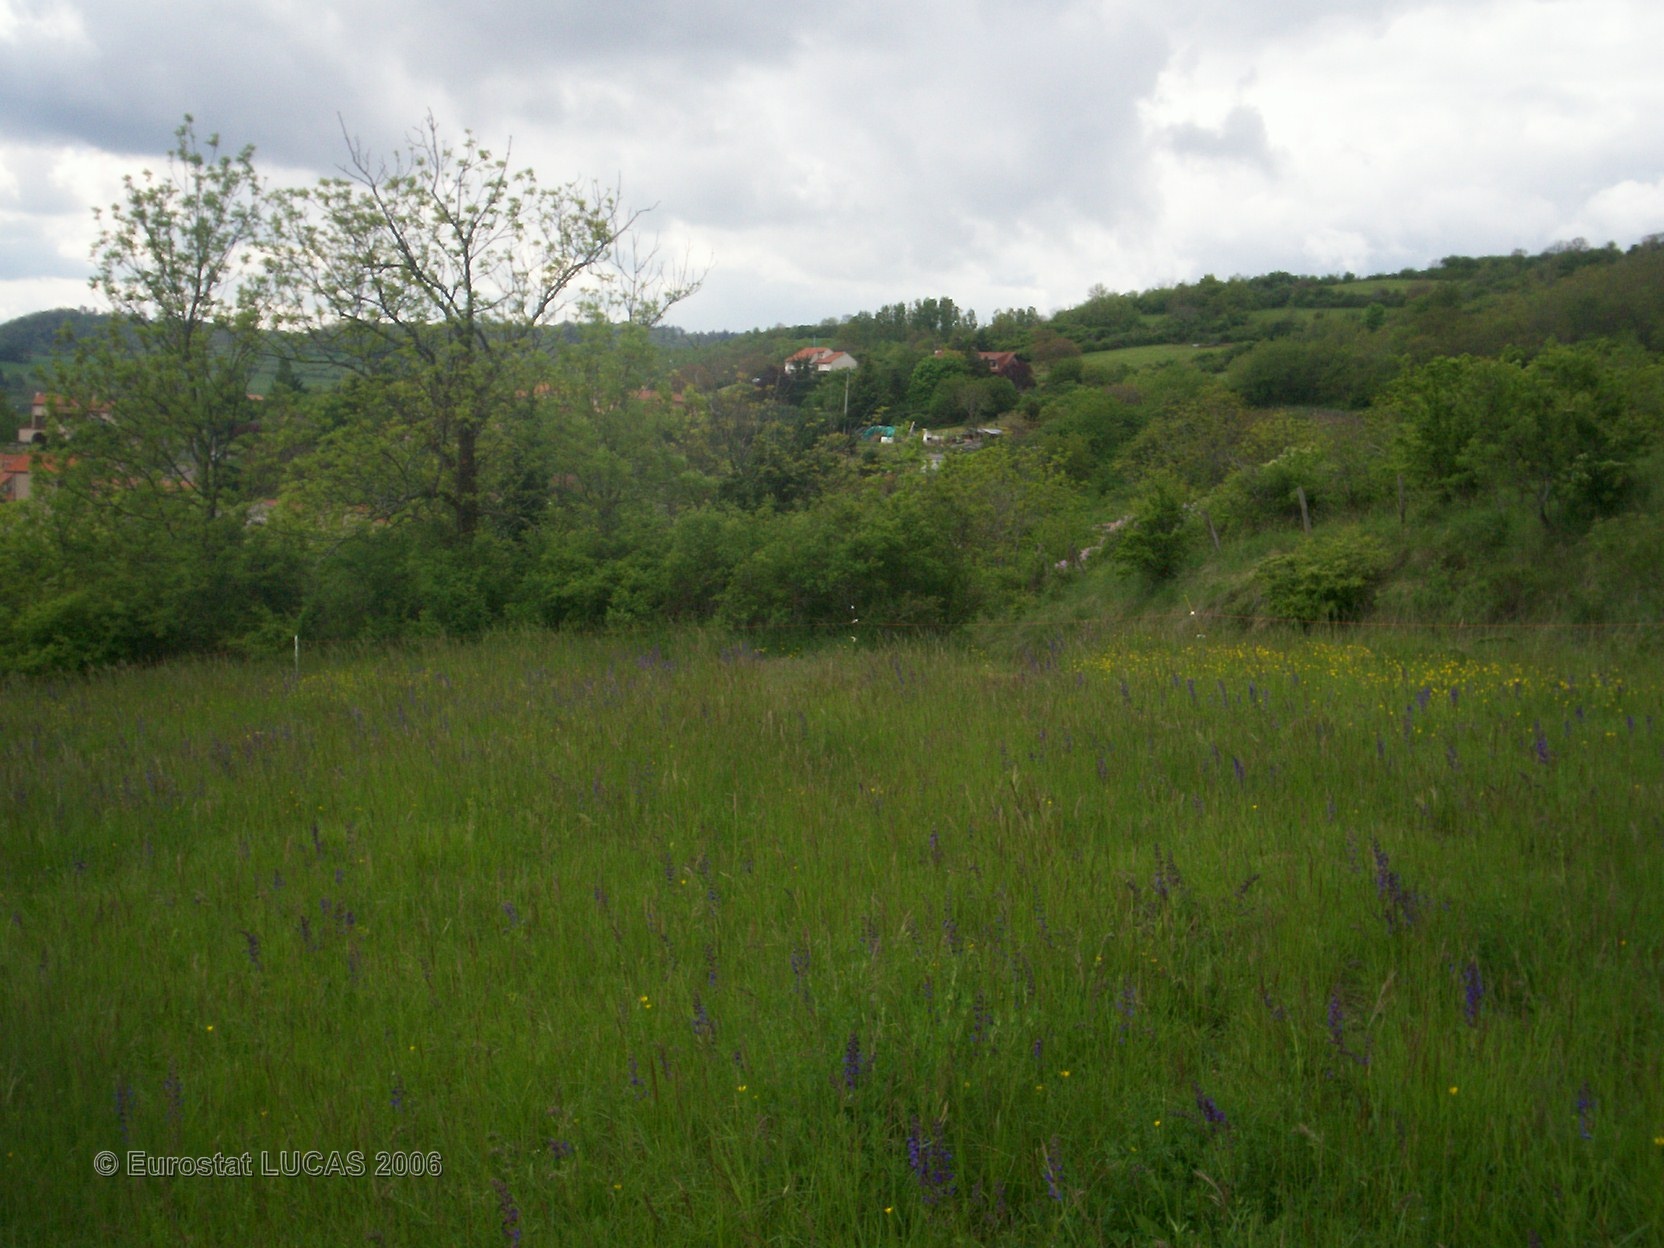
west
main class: Grassland
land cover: Grassland without tree/shrub cover
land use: Agriculture (excluding fallow land and kitchen gardens)
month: May
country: FR
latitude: 45.7143
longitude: 3.1272
